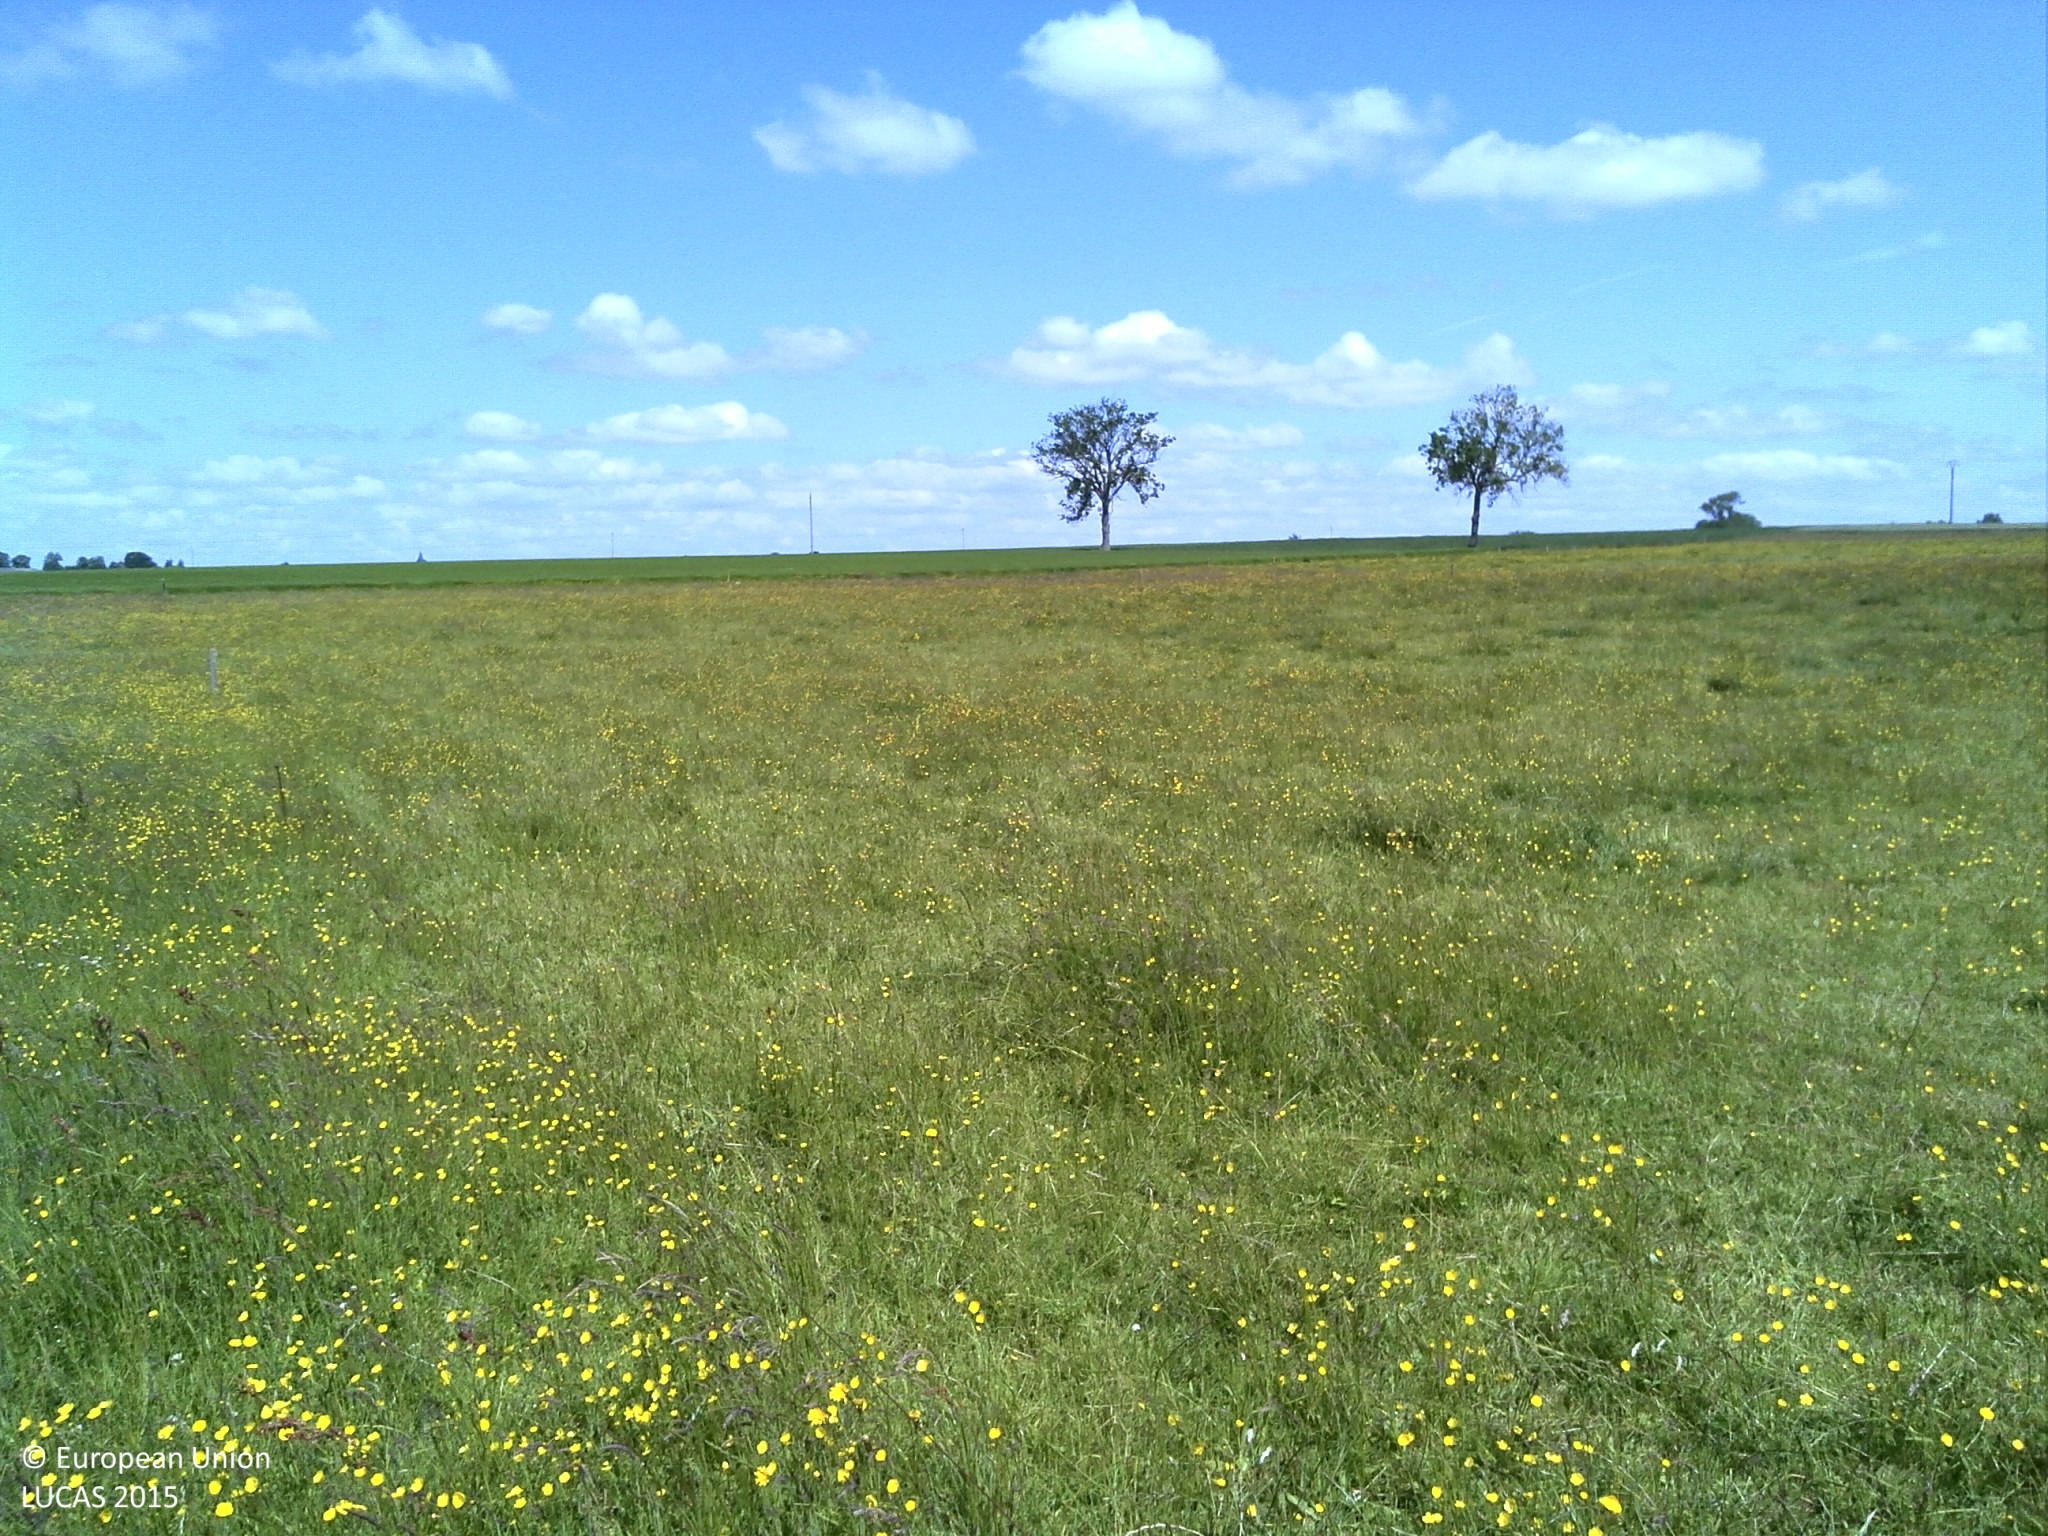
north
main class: Grassland
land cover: Grassland without tree/shrub cover
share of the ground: > 75 %
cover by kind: herbaceous plants 100 %
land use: Agriculture (excluding fallow land and kitchen gardens)
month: June
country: FR
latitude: 49.5298
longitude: 1.1223
